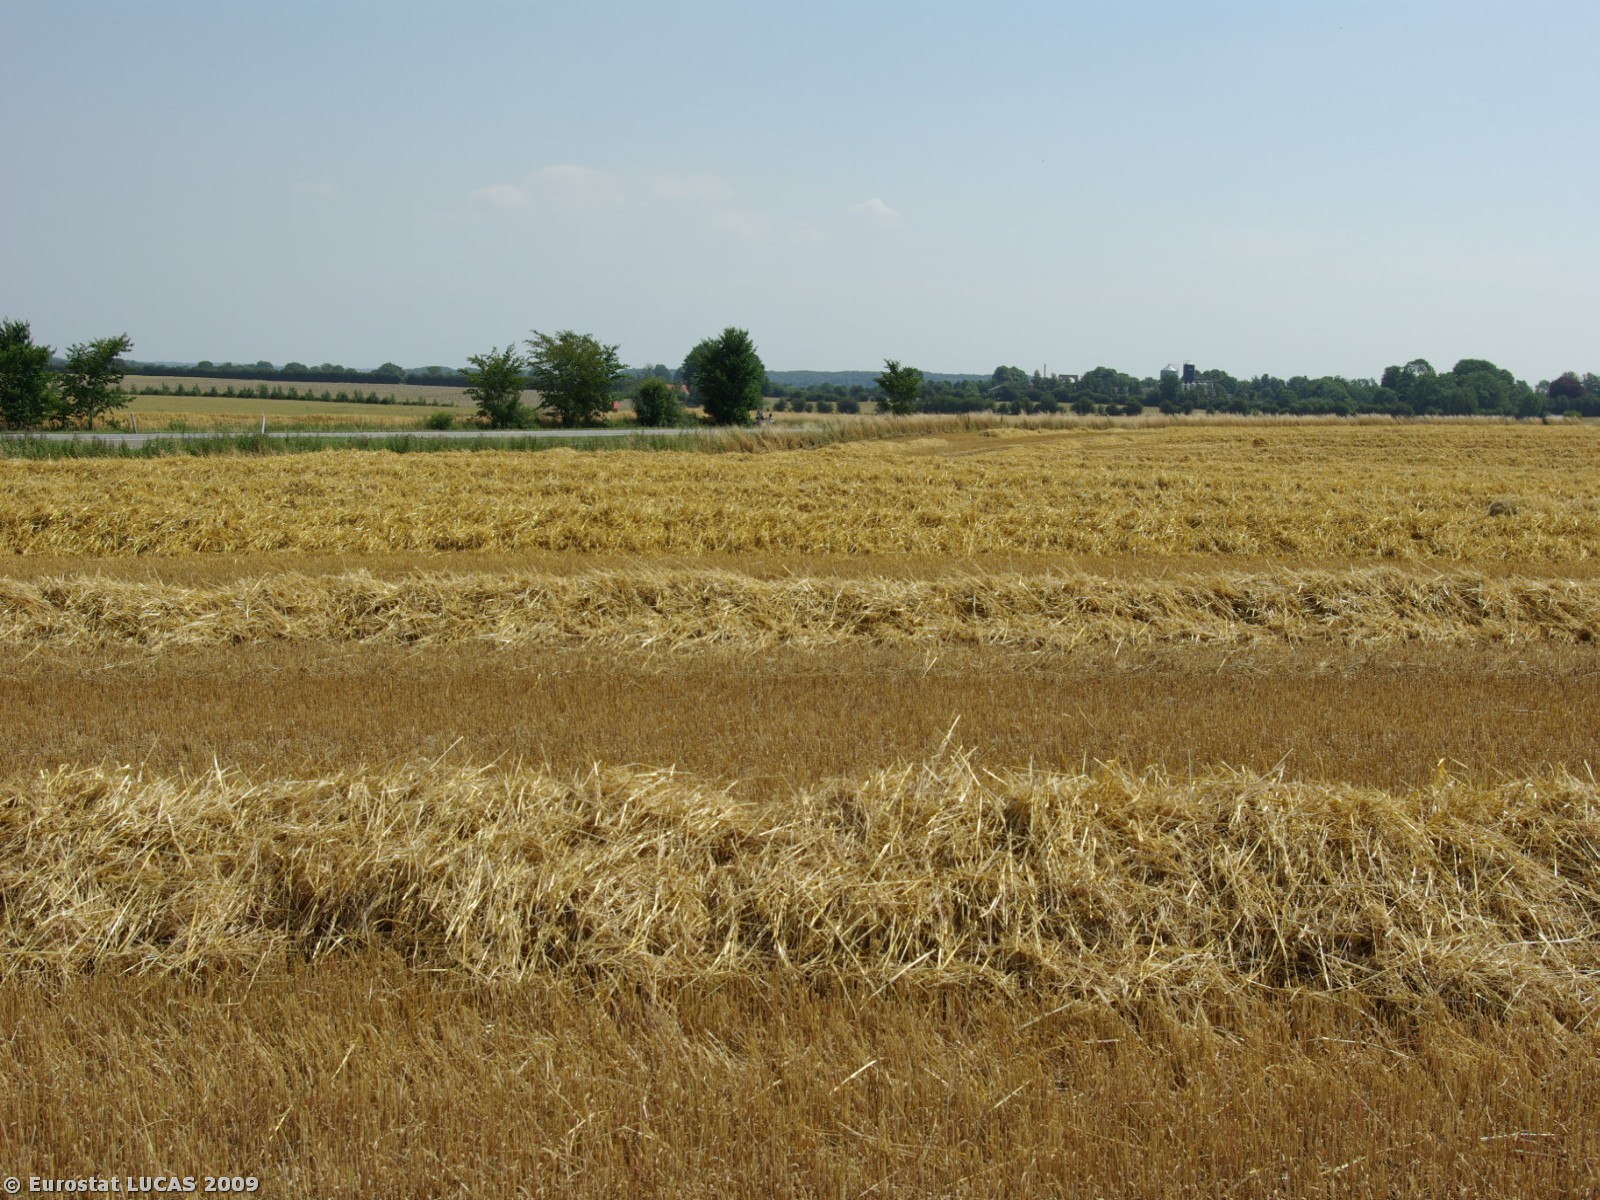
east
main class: Cropland
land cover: Common wheat
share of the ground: > 75 %
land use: Agriculture (excluding fallow land and kitchen gardens)
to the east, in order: Common wheat; Tracks; Barley; Grass margins; Ditches and canals; Grass margins; Tracks; Grass margins; Paved roads, cycling and walking lanes; Grass margins; Tracks; Grass margins; Ditches and canals; Grass margins; Barley
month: July
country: DK
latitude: 54.9651
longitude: 9.6723
